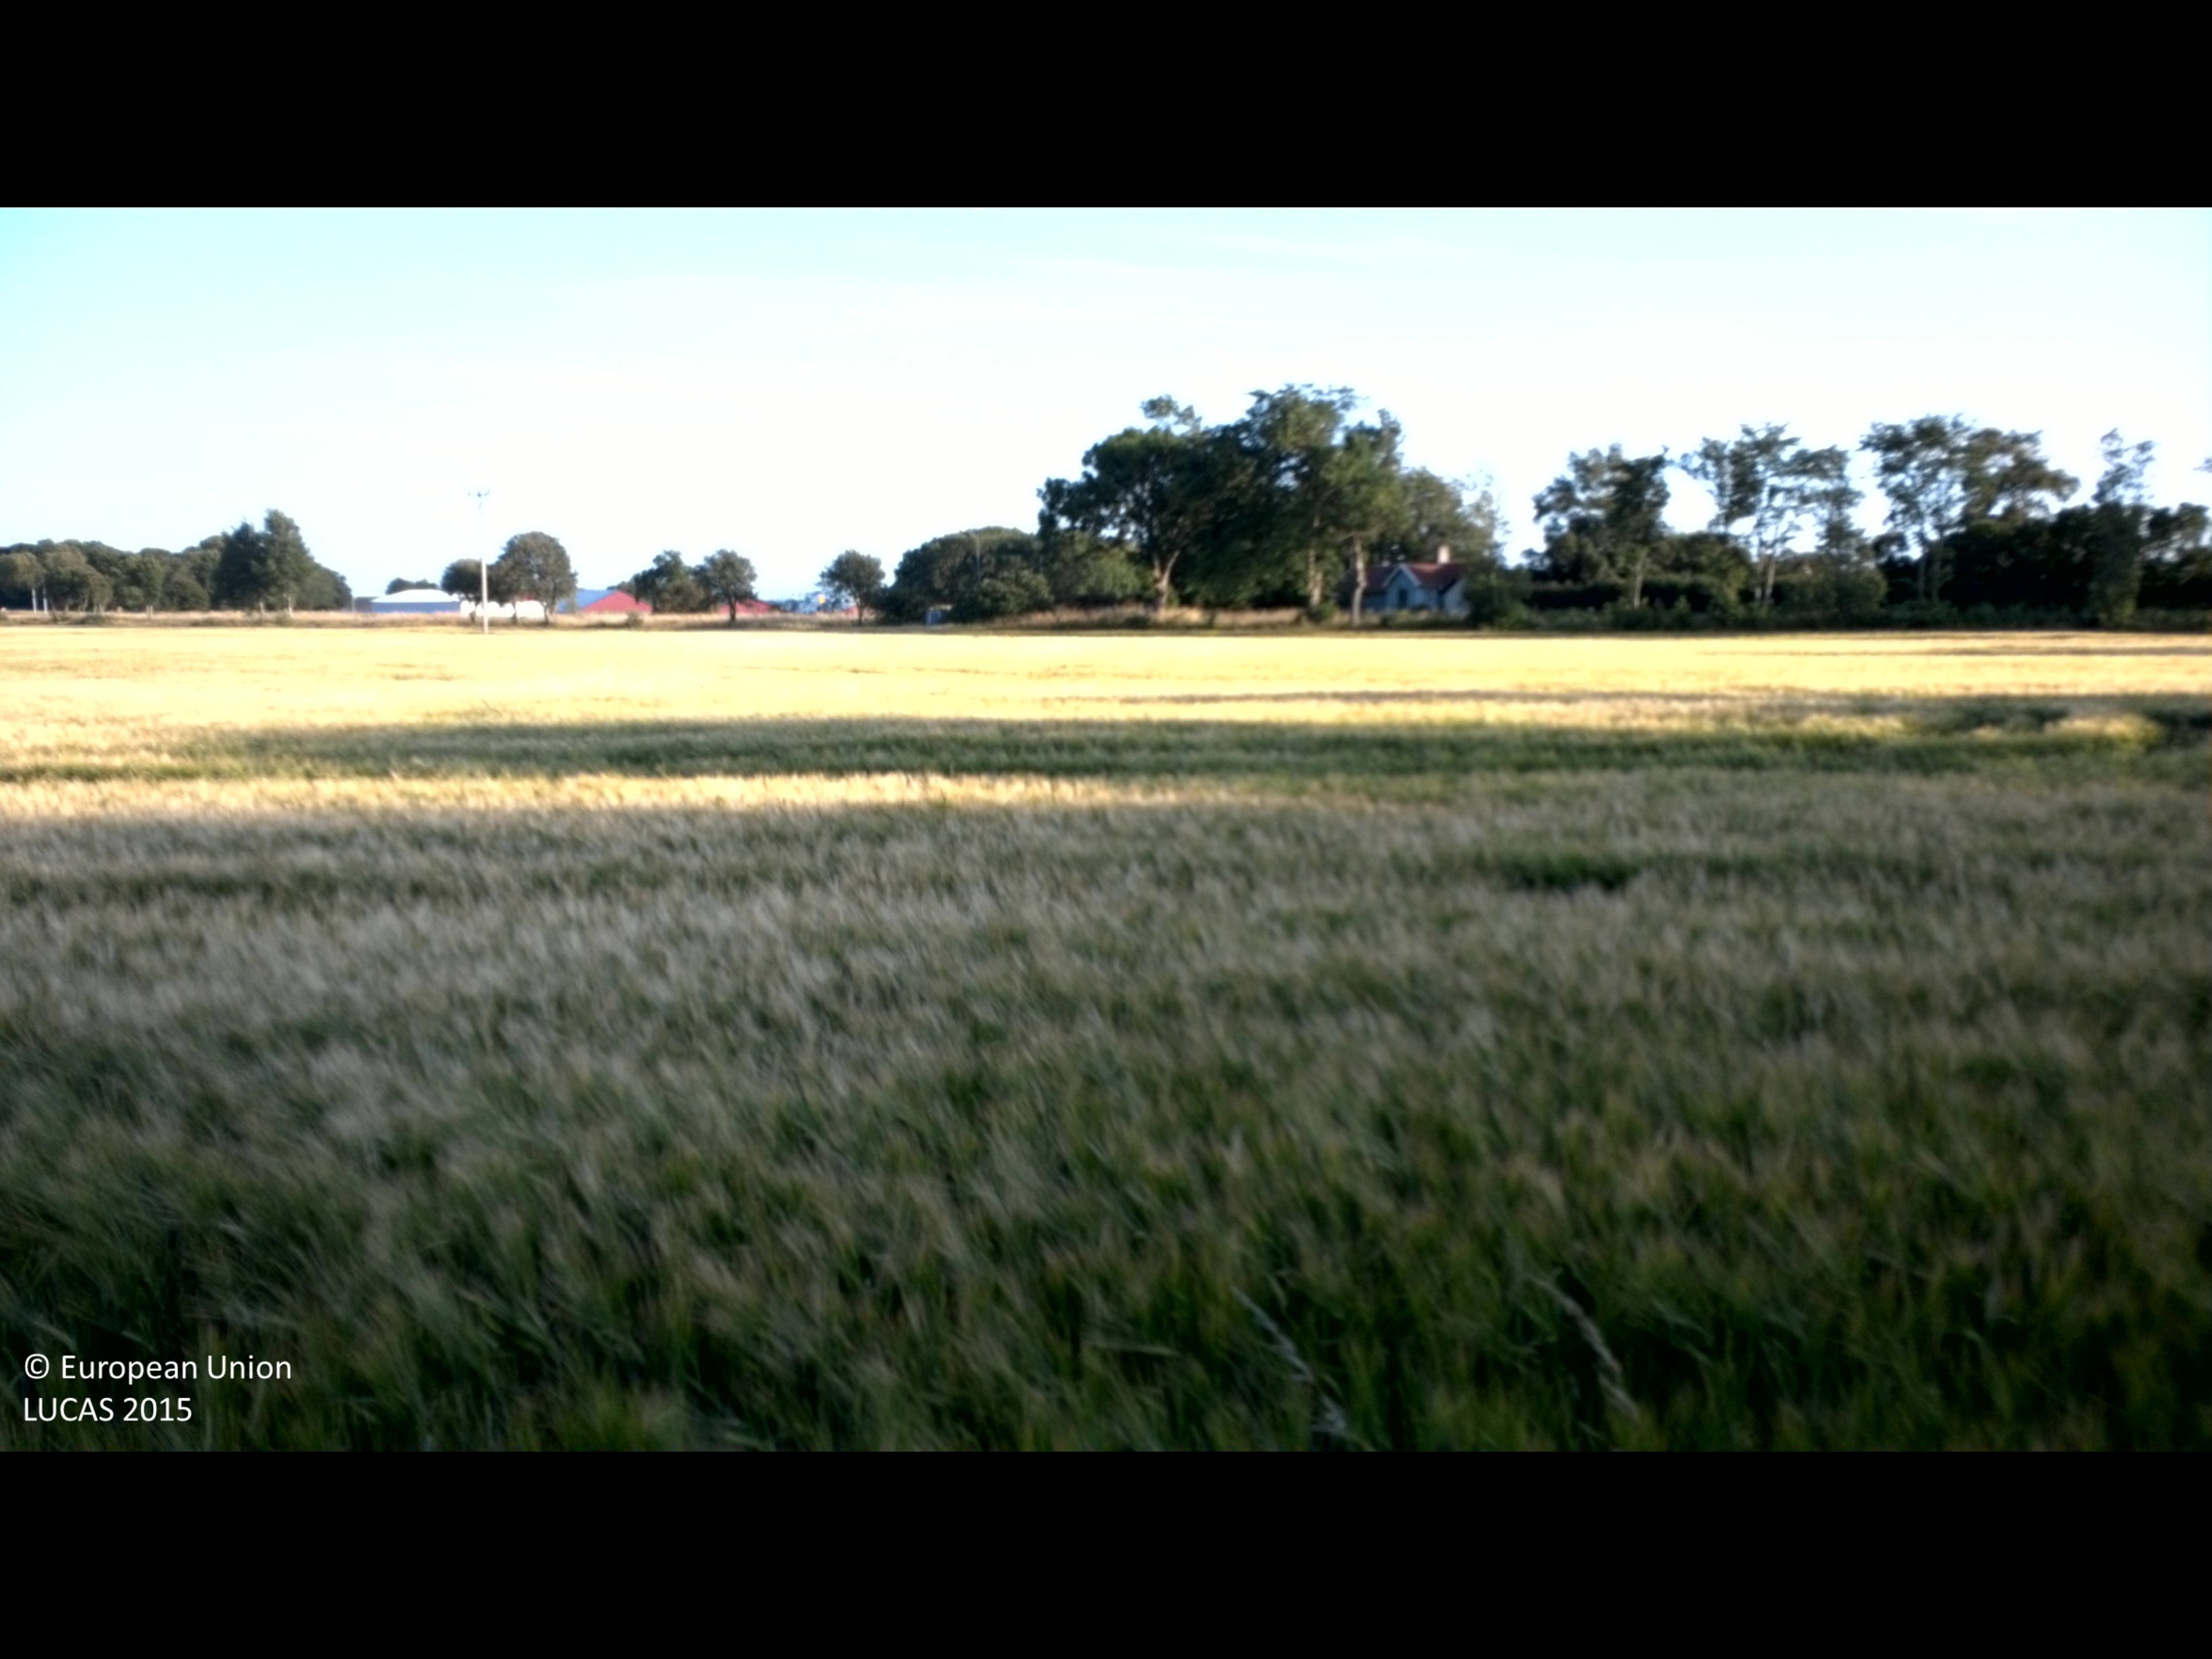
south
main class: Cropland
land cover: Barley
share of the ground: > 75 %
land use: Agriculture (excluding fallow land and kitchen gardens)
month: July
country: SE
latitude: 56.2620
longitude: 16.4113
